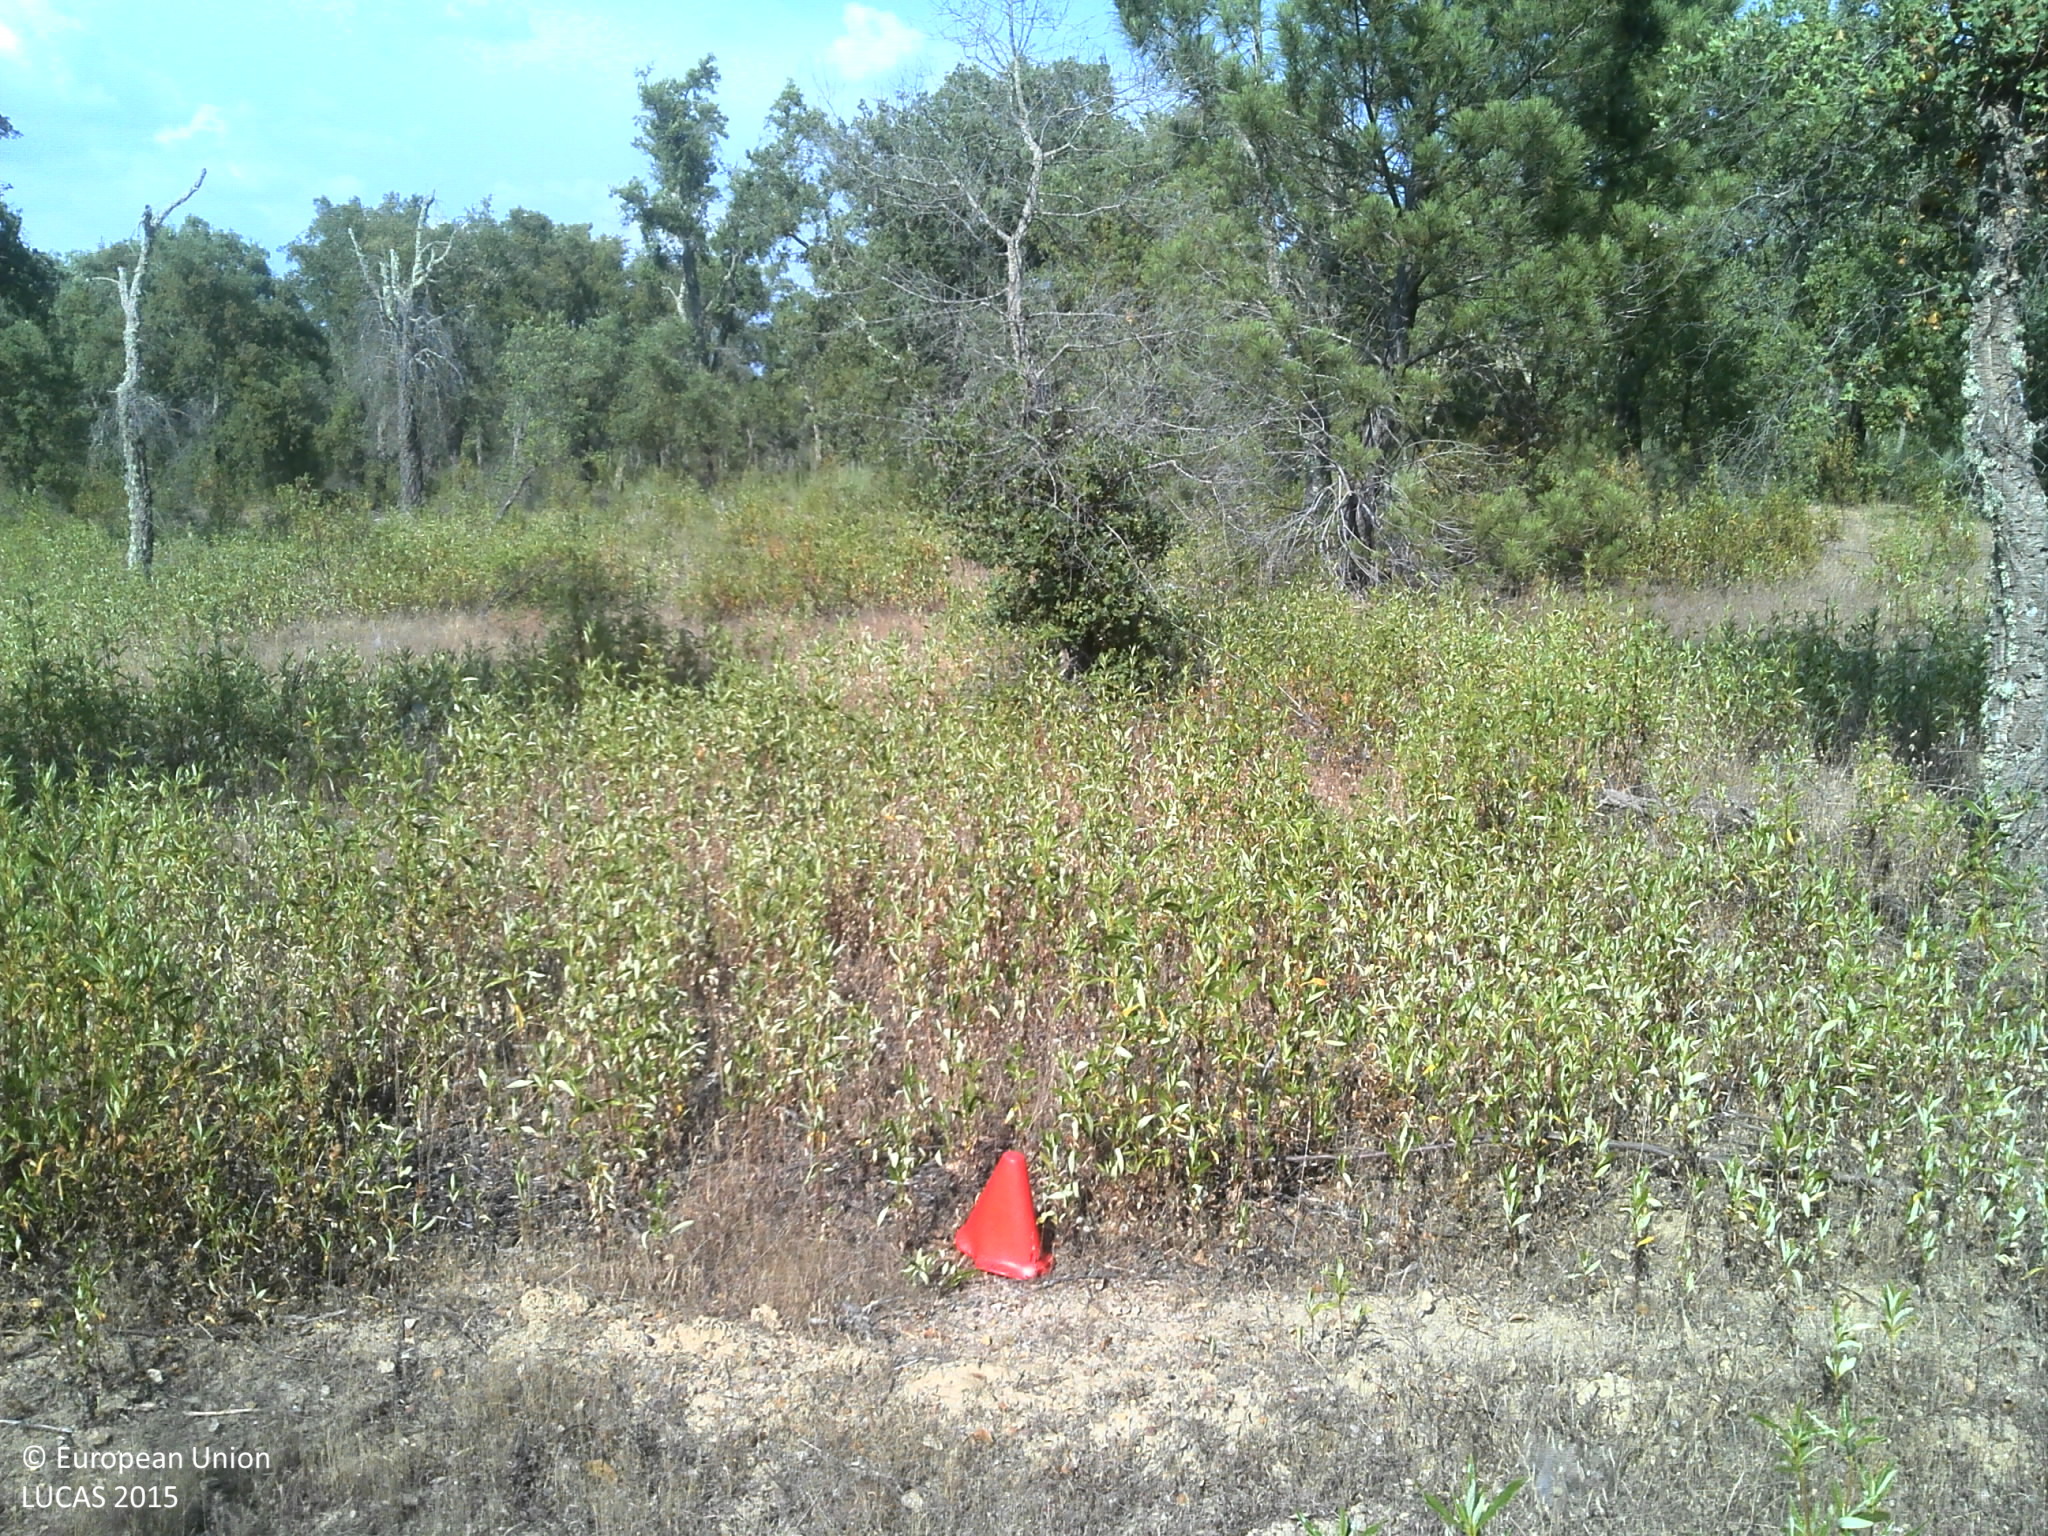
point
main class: Woodland
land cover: Broadleaved woodland
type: broadleaved evergreen forest
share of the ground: 10 - 25 %
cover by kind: shrubs 40 %, broadleaved forest trees 25 %, herbaceous plants 20 %, unconsolidated bare surface 15 %
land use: Forestry
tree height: > 5 m
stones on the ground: 10 - 25 %
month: June
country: PT
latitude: 39.4005
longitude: -7.9985
